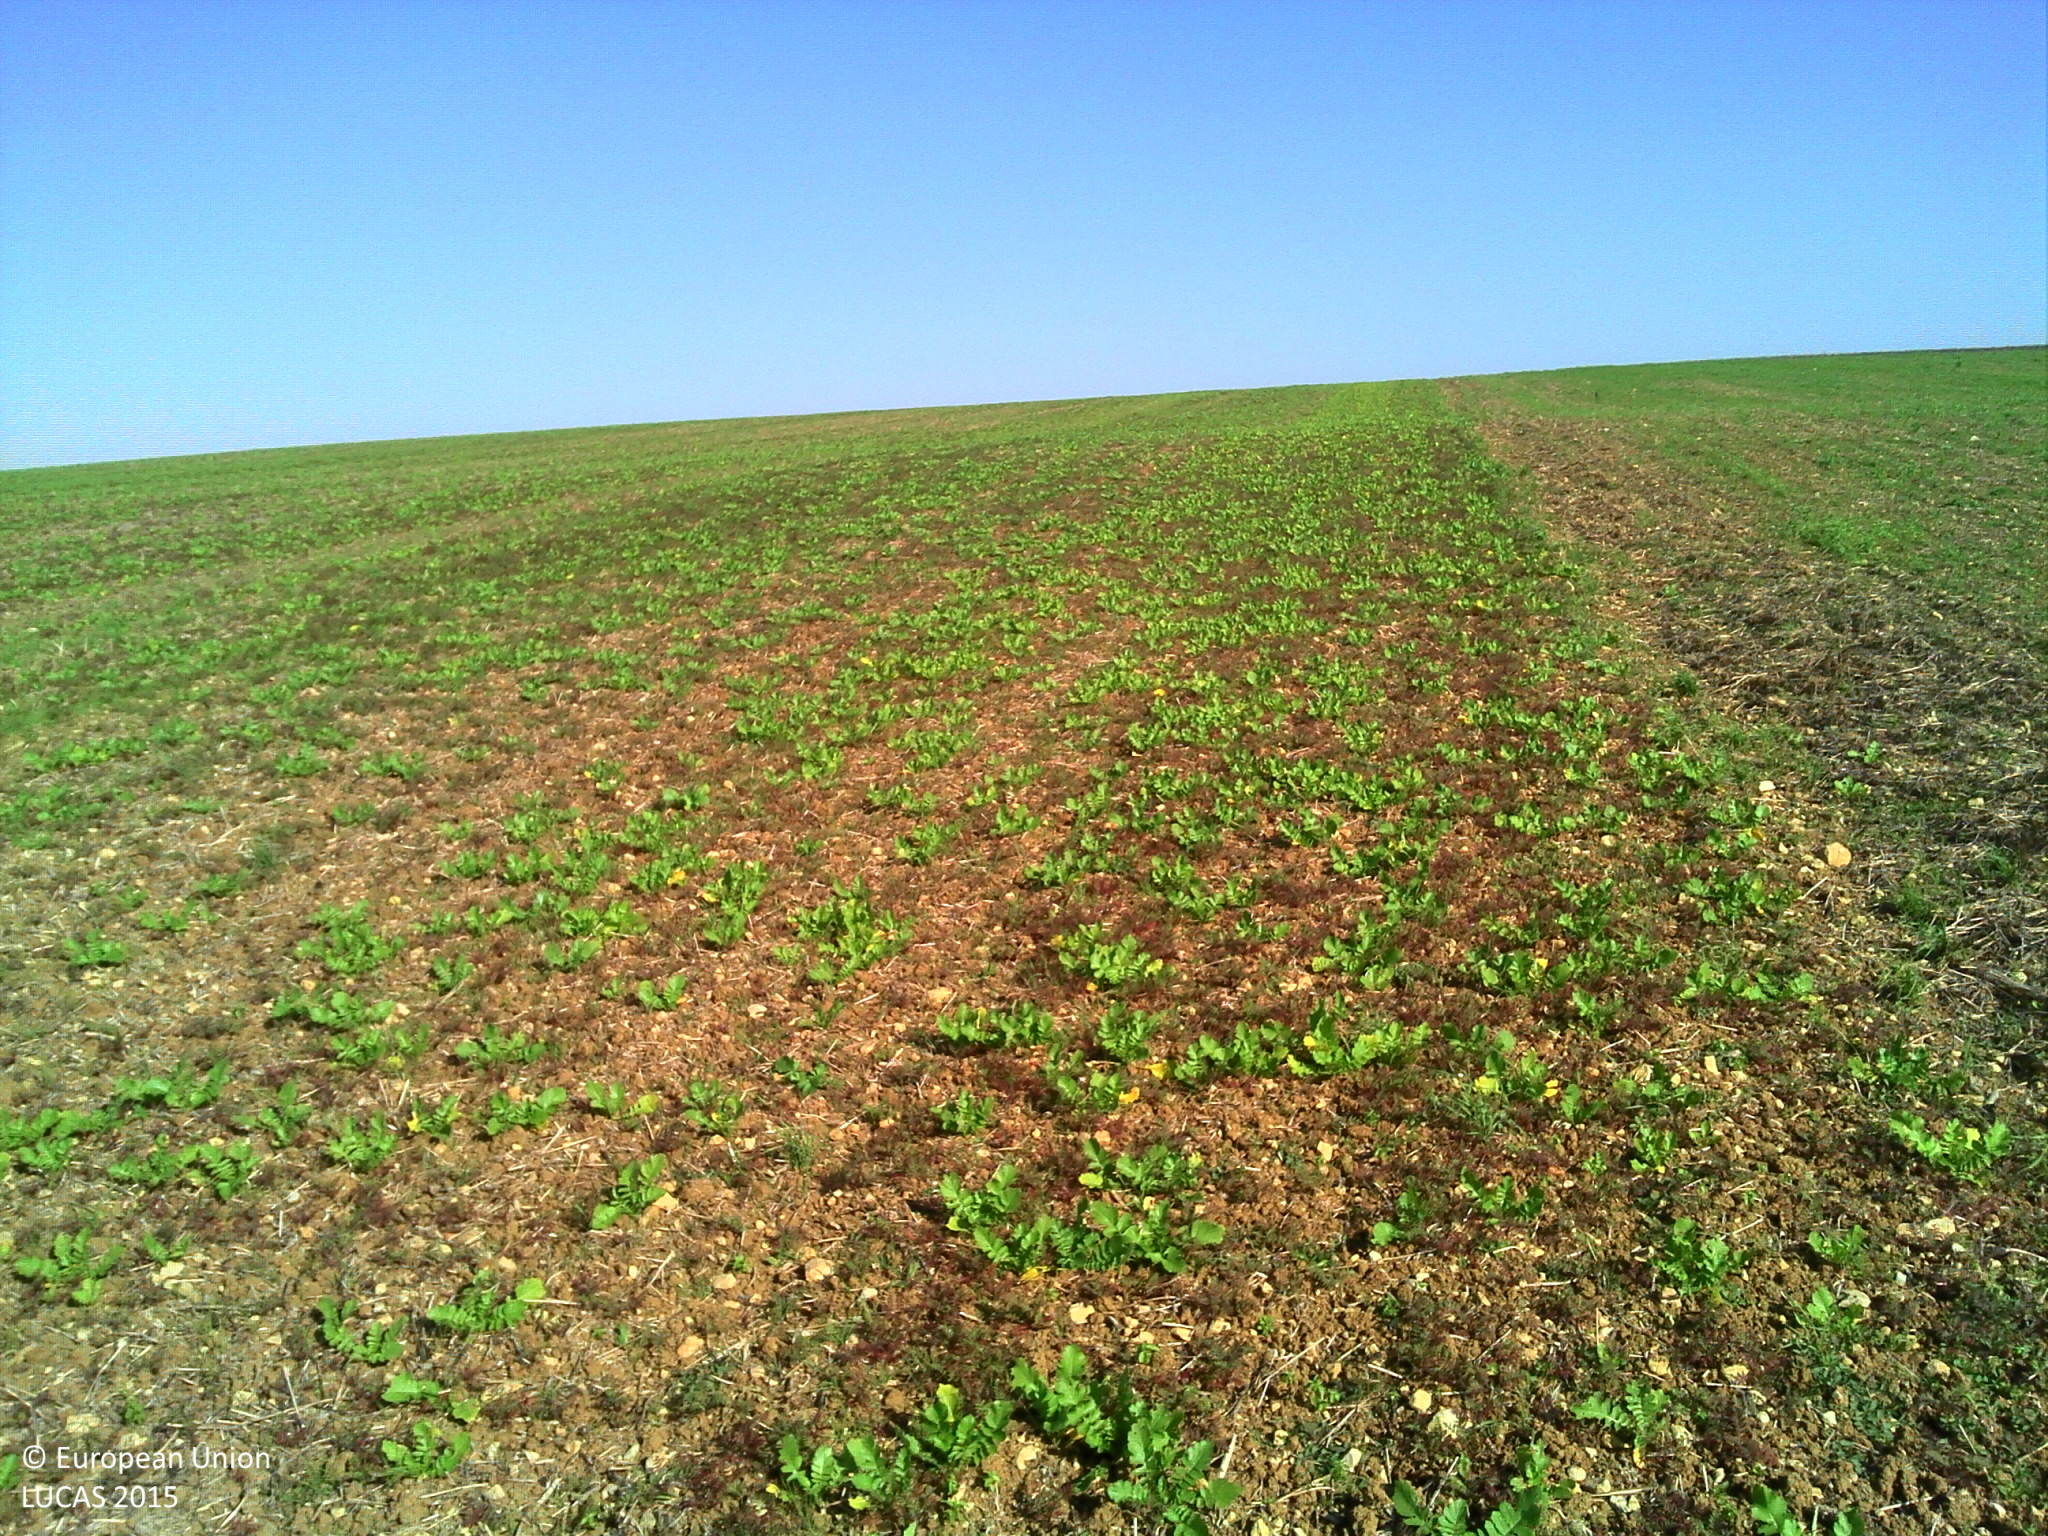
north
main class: Cropland
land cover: Other leguminous and mixtures for fodder
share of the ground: 10 - 25 %
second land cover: Other root crops
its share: 10 - 25 %
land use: Agriculture (excluding fallow land and kitchen gardens)
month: September
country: FR
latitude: 46.5603
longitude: -1.0292
